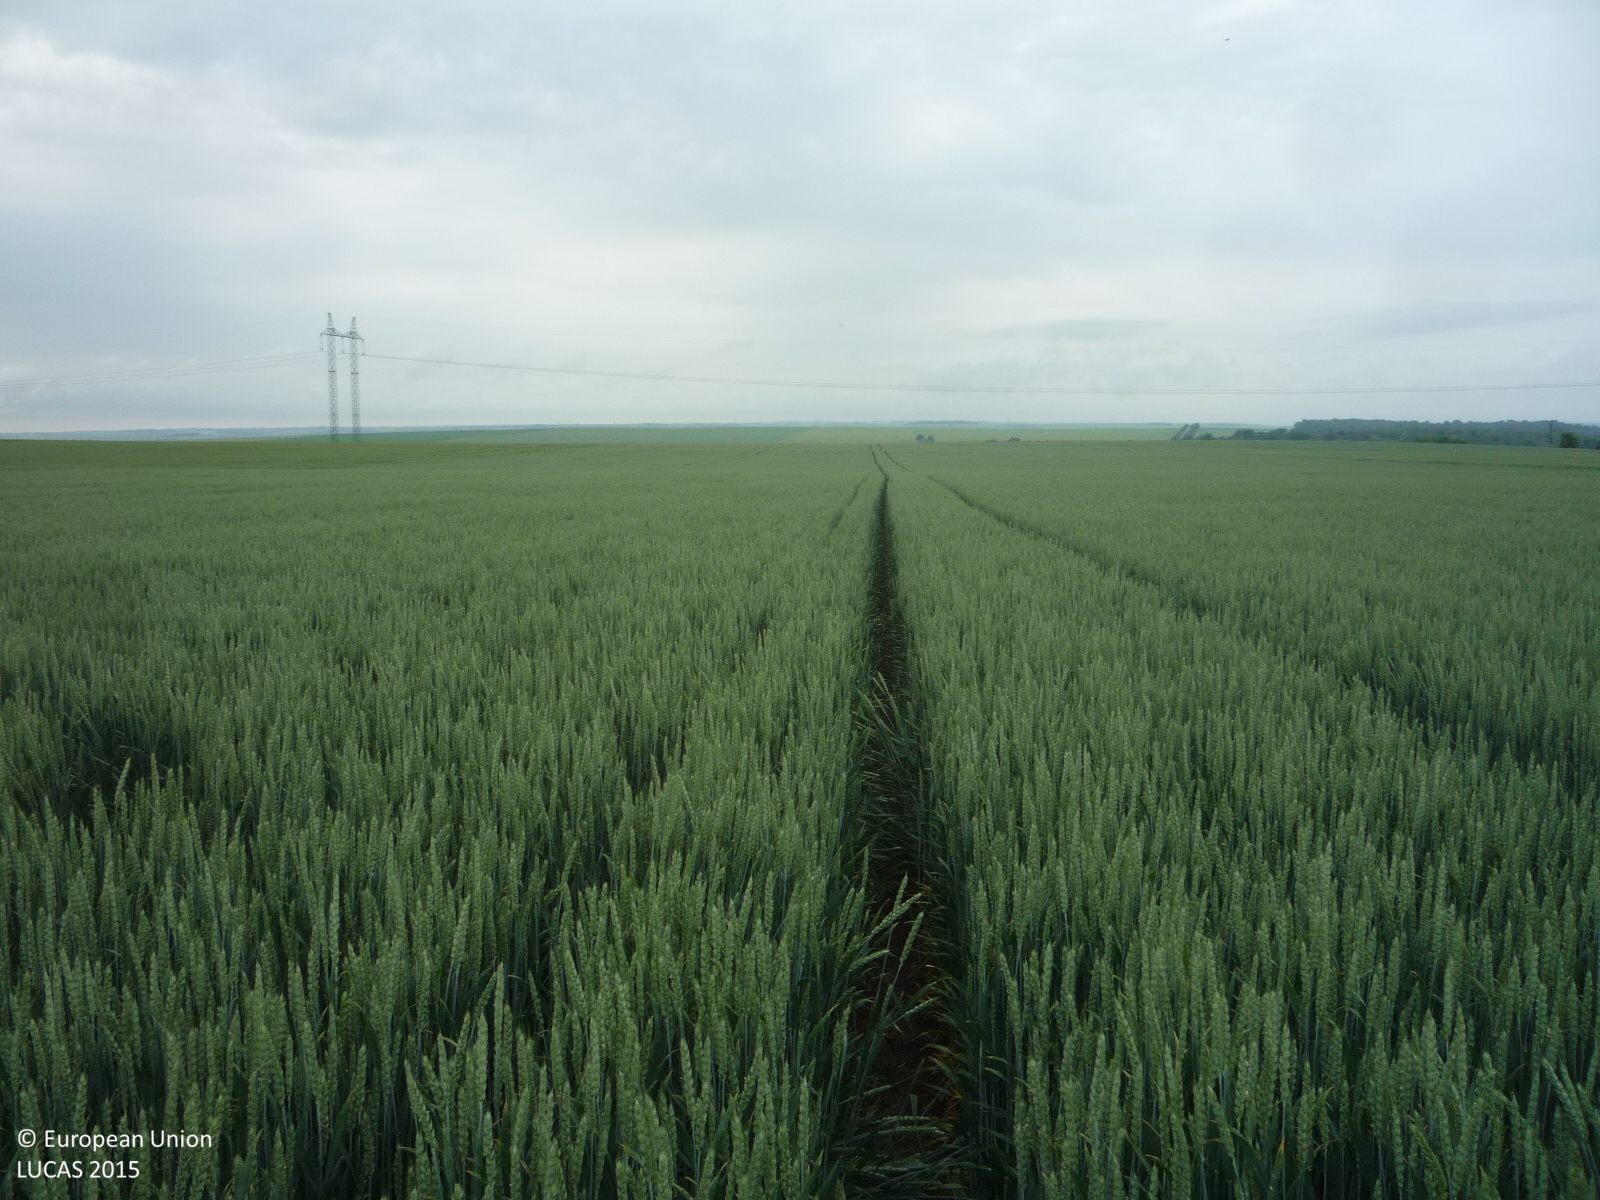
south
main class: Cropland
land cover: Common wheat
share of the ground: > 75 %
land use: Agriculture (excluding fallow land and kitchen gardens)
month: June
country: CZ
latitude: 50.3260
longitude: 14.1168
